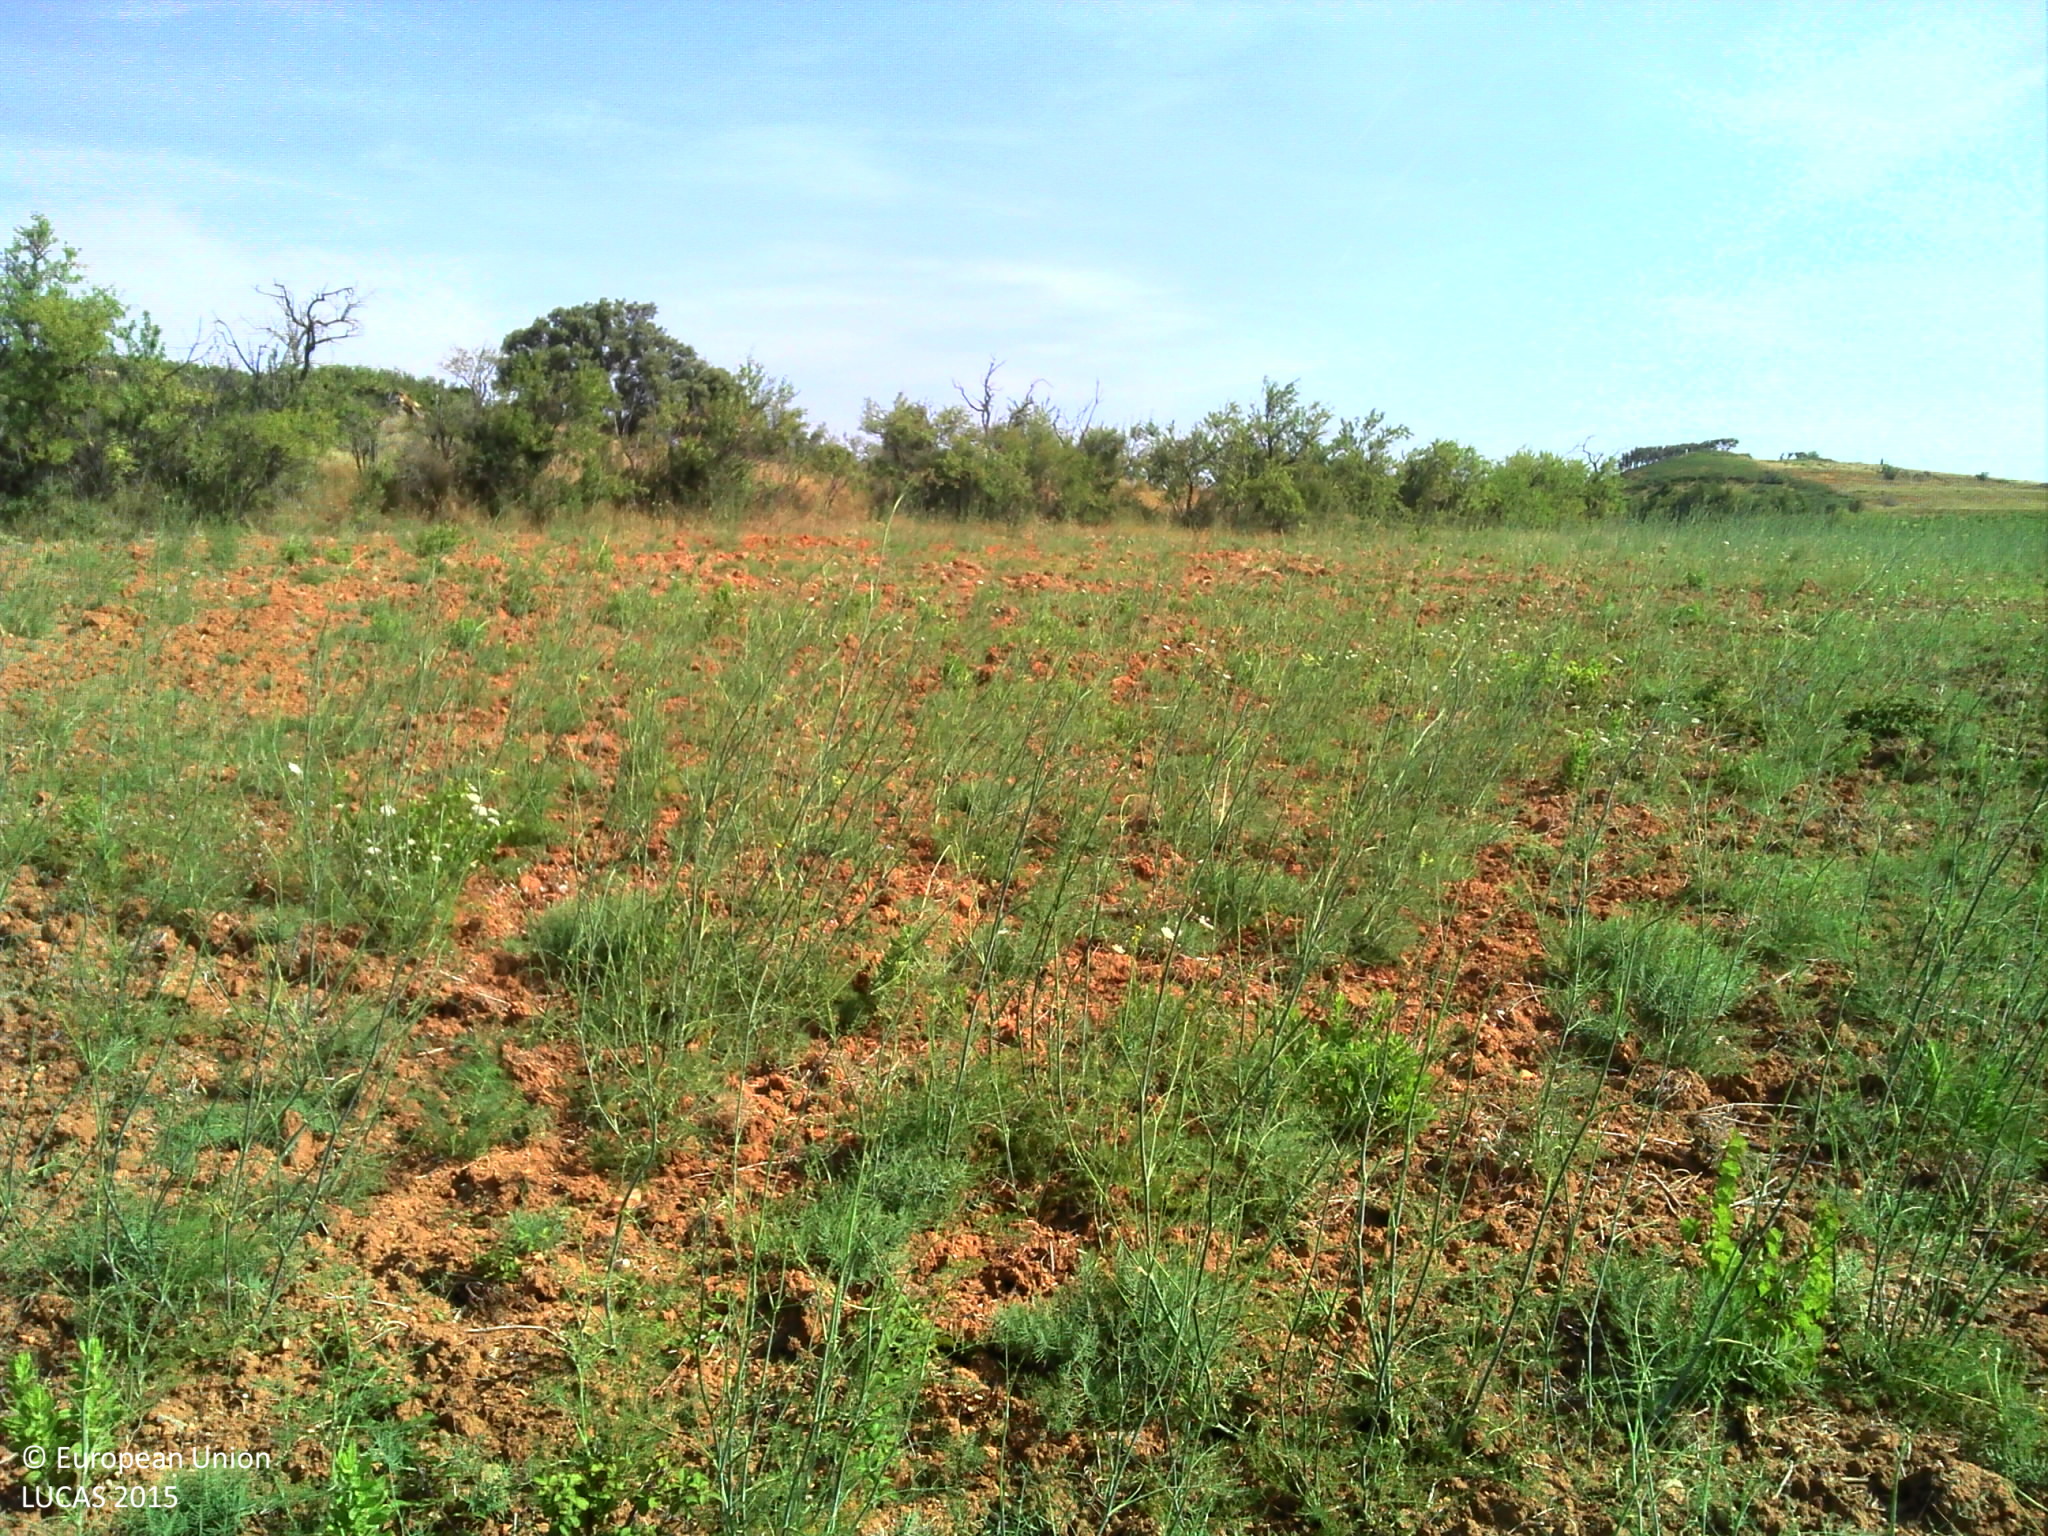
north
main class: Grassland
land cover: Spontaneously vegetated surfaces
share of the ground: > 75 %
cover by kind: herbaceous plants 100 %
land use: Fallow land
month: July
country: FR
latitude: 43.1707
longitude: 2.7148
